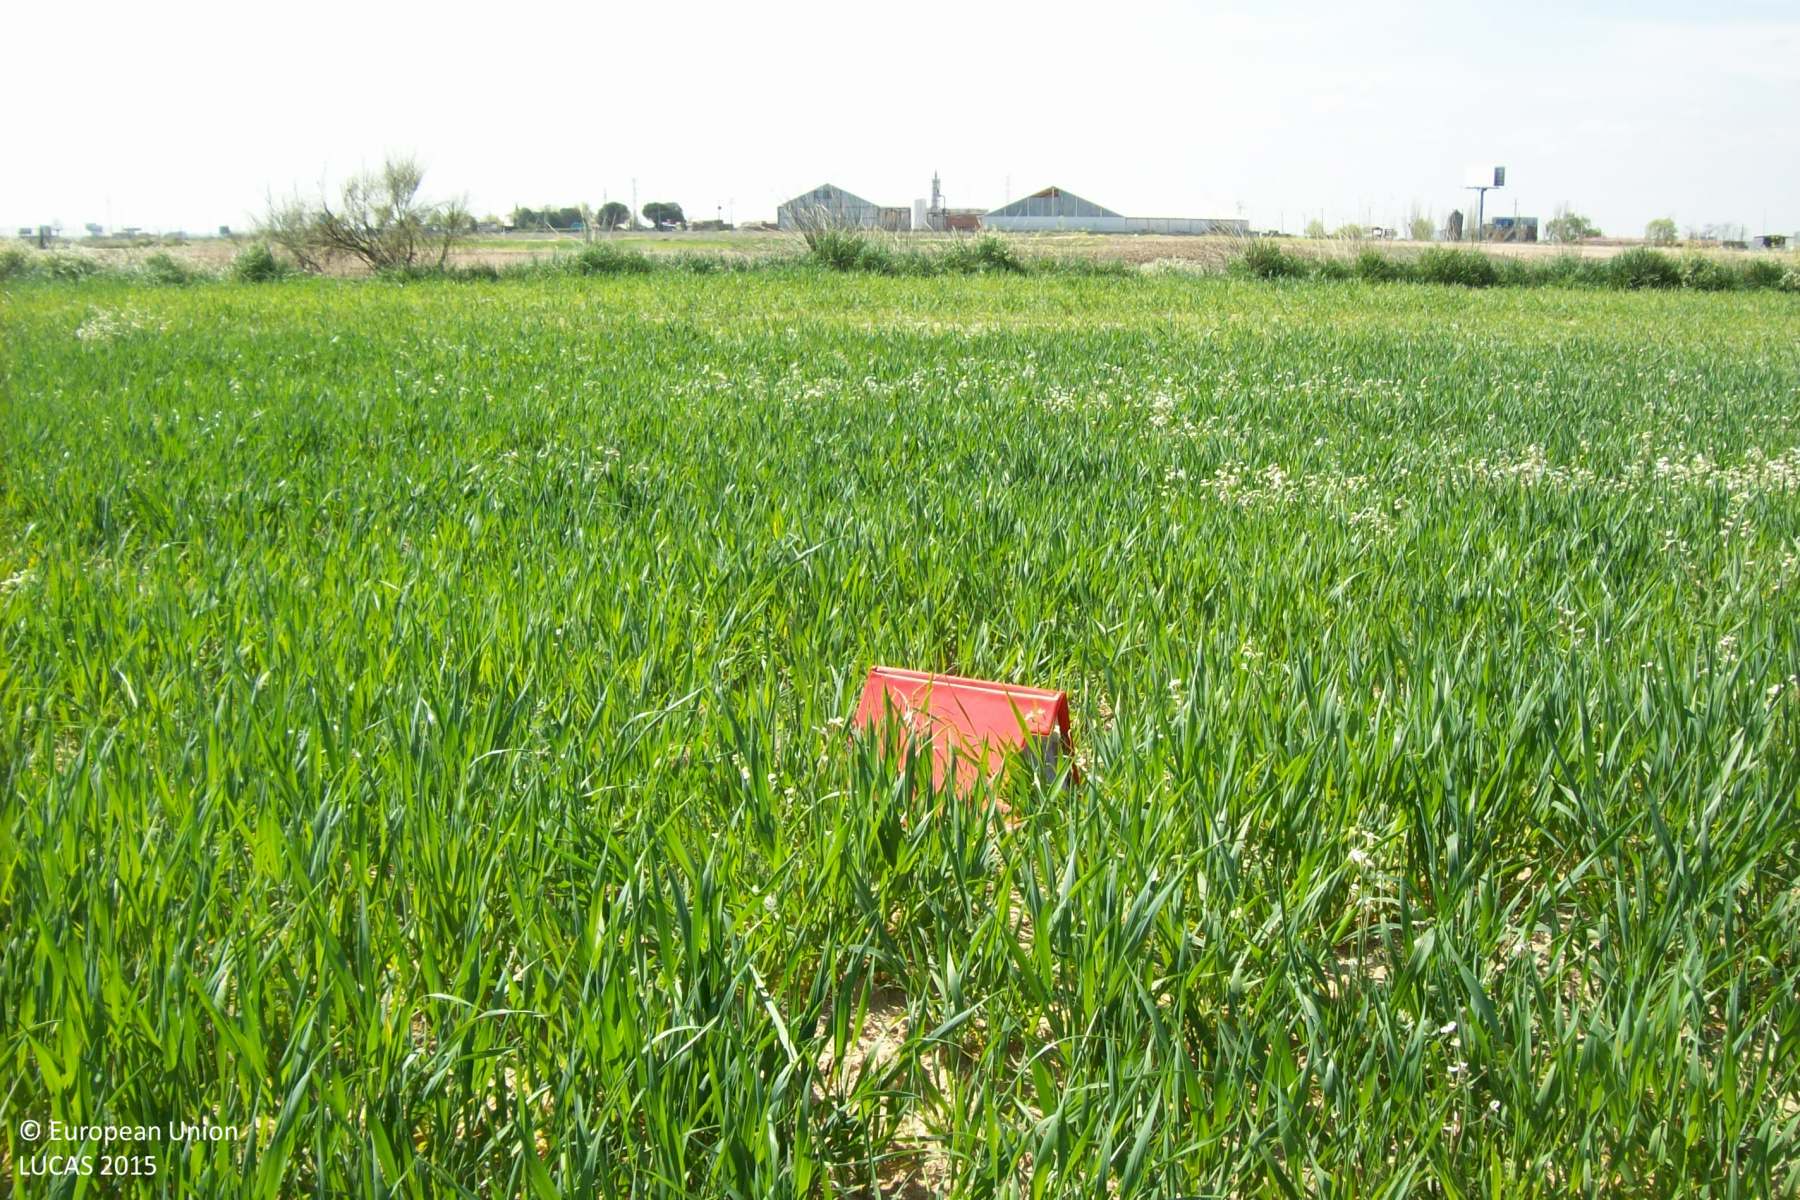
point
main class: Cropland
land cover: Barley
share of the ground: > 75 %
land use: Agriculture (excluding fallow land and kitchen gardens)
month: April
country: ES
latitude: 40.3607
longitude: -3.8514
